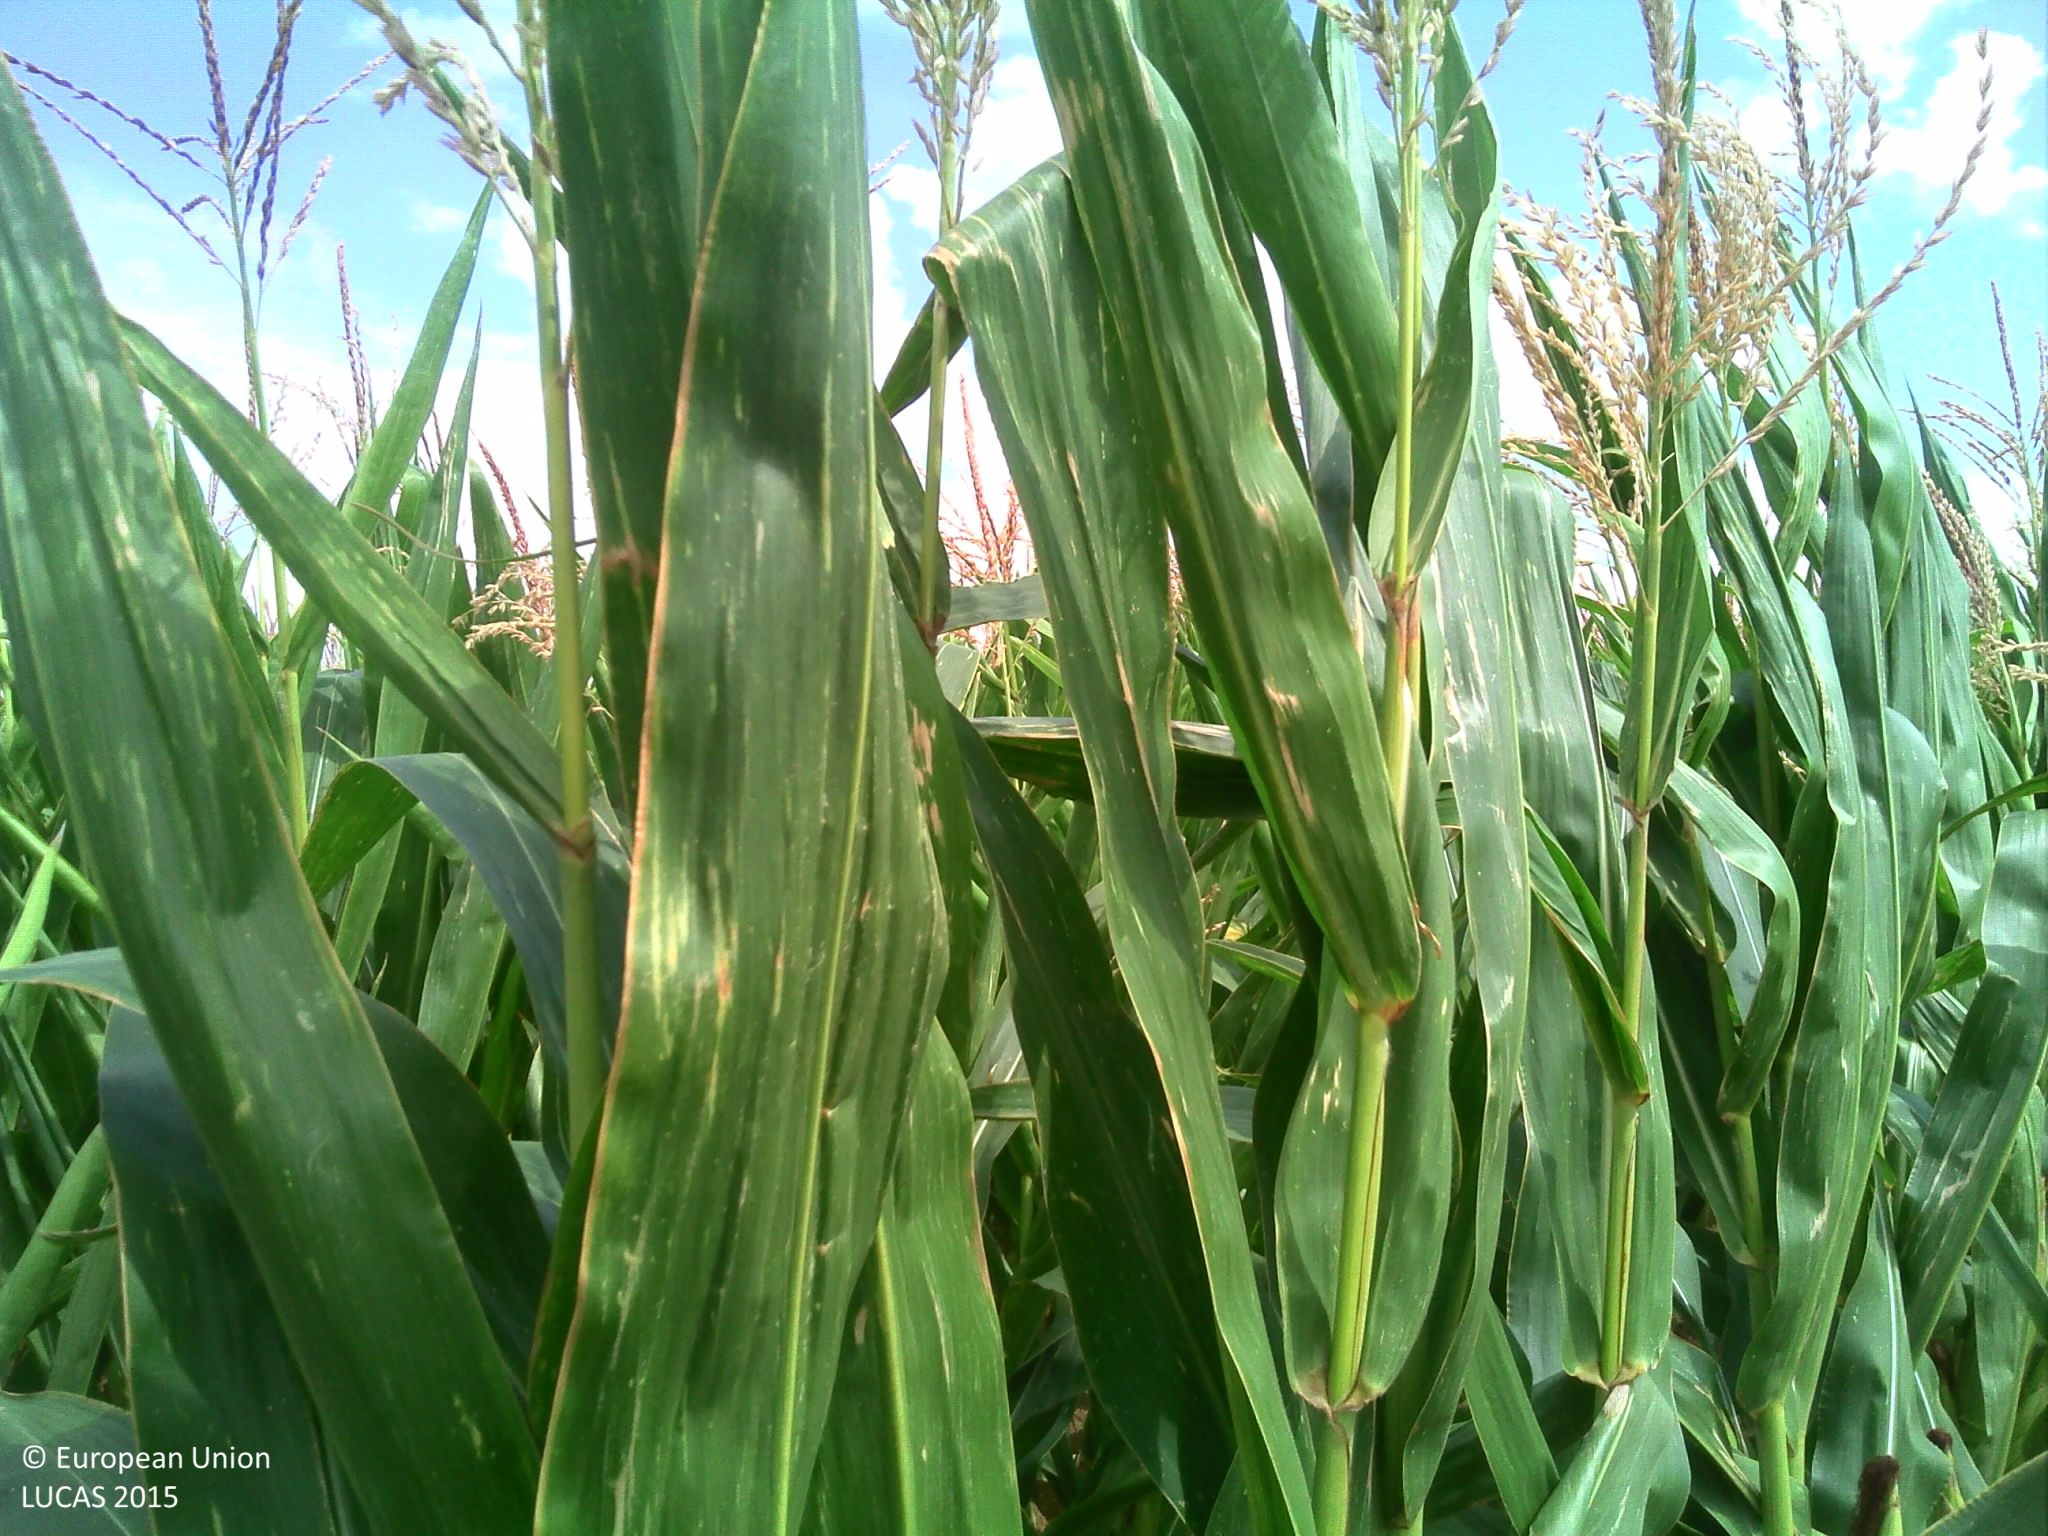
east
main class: Cropland
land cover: Maize
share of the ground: > 75 %
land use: Agriculture (excluding fallow land and kitchen gardens)
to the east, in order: Maize
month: August
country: FR
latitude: 49.0343
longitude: 2.5065
